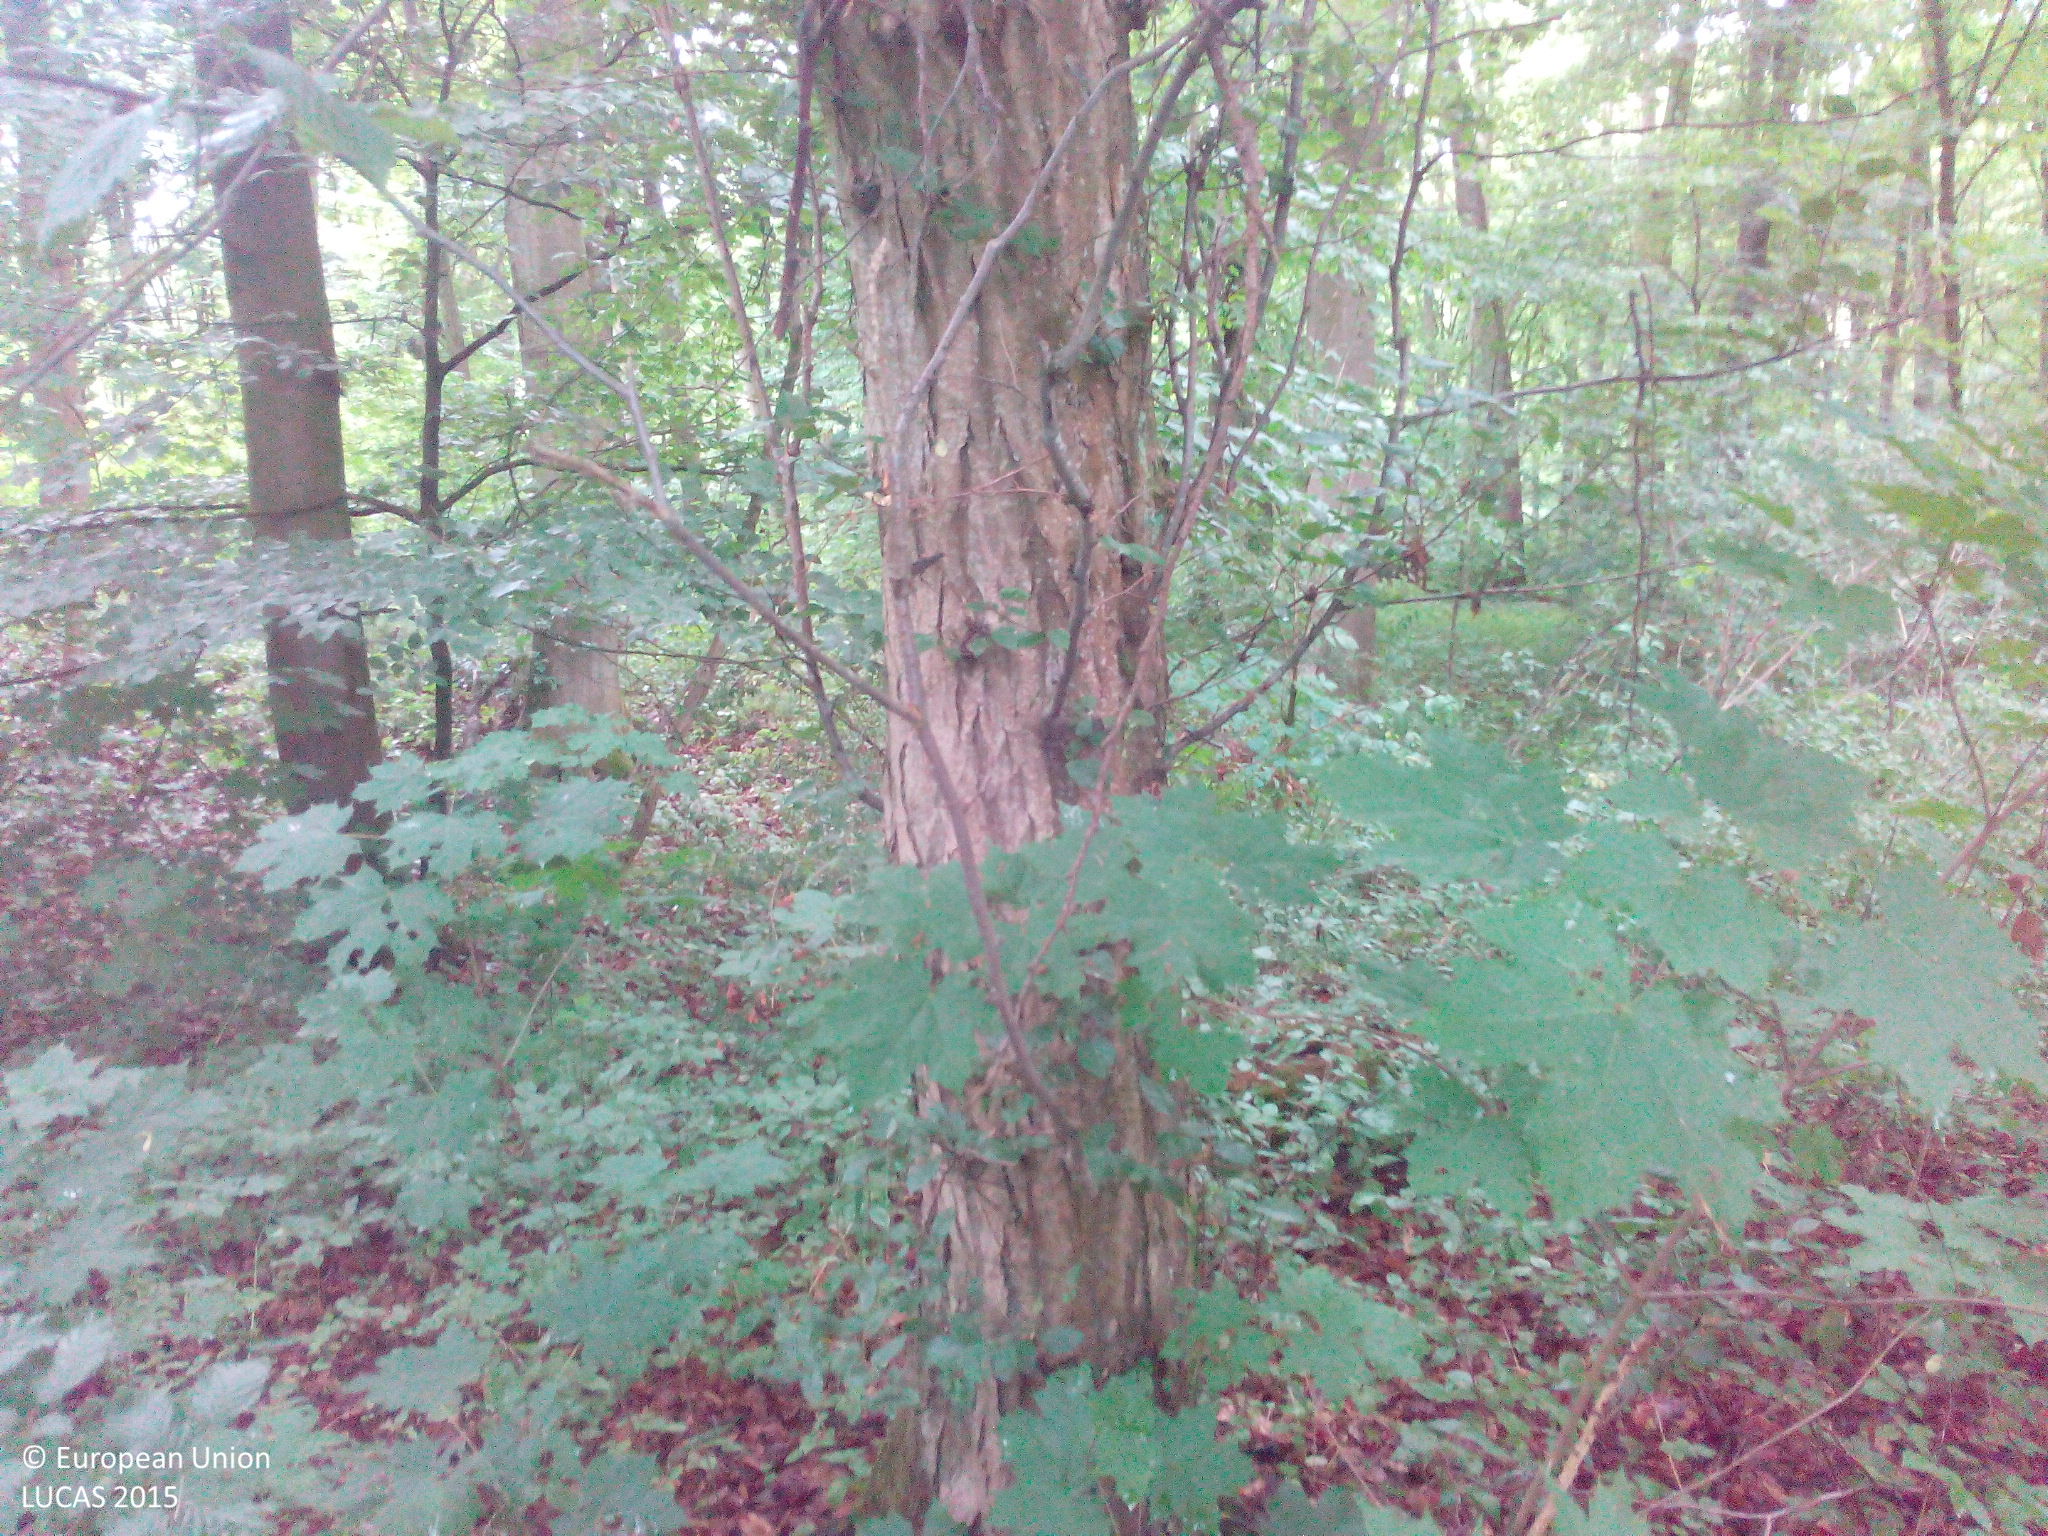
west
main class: Woodland
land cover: Broadleaved woodland
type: mesophytic deciduous forest
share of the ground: > 75 %
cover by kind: broadleaved forest trees 100 %
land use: Amenities, museums, leisure
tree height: > 5 m
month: June
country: DE
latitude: 49.8749
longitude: 10.9042
